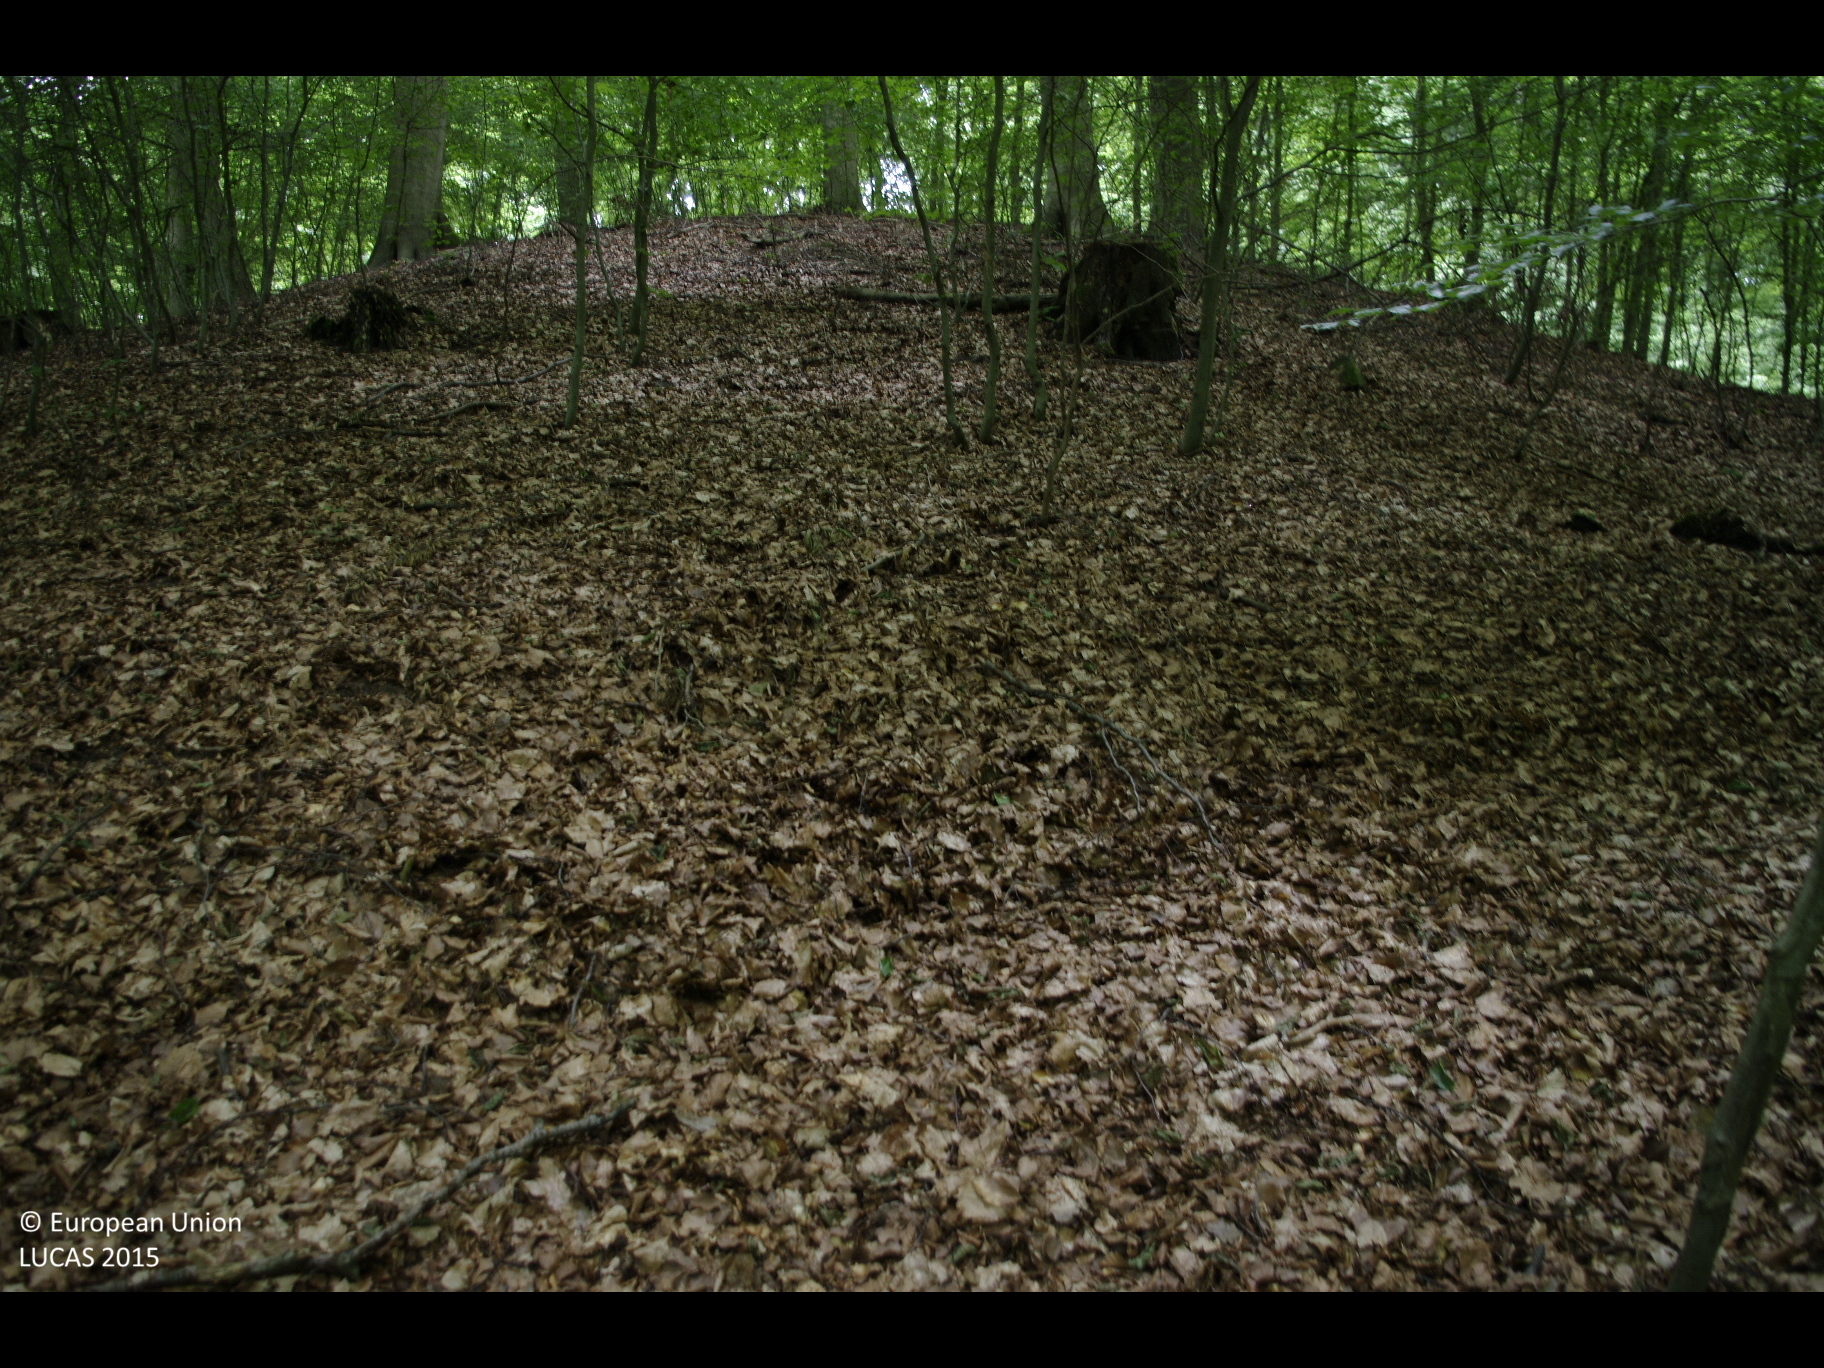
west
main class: Woodland
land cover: Broadleaved woodland
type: mesophytic deciduous forest
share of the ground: > 75 %
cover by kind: broadleaved forest trees 90 %, herbaceous plants 5 %, unconsolidated bare surface 5 %
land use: Forestry
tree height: > 5 m
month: July
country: DE
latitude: 53.4558
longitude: 9.9247
